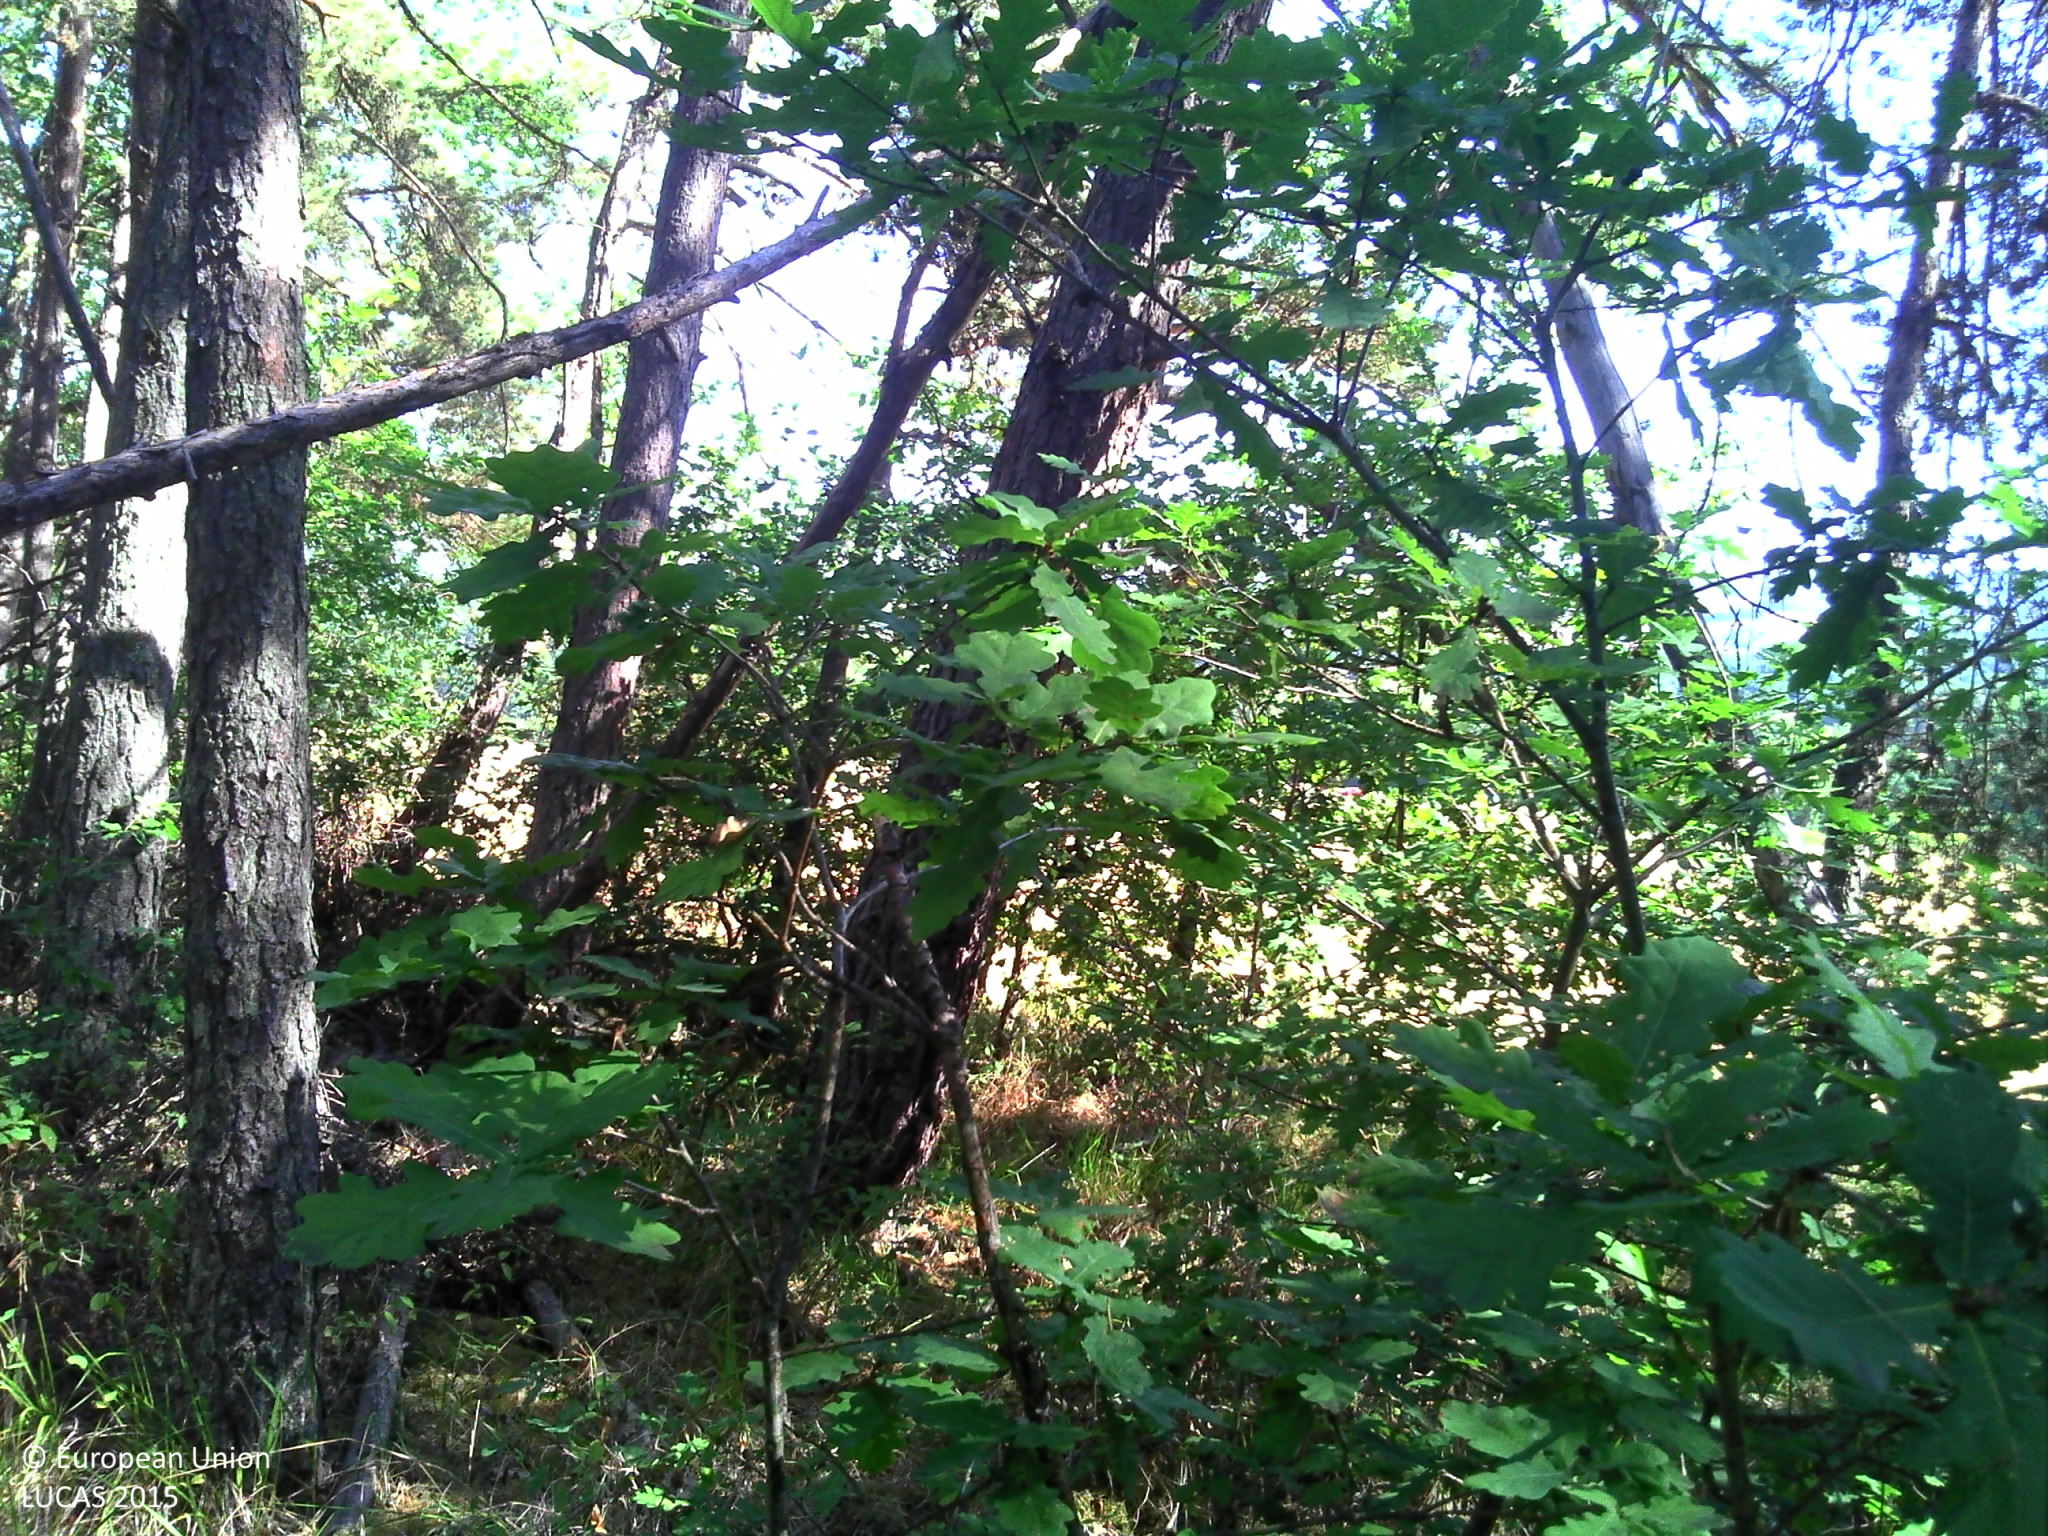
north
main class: Woodland
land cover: Pine dominated mixed woodland
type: acidophilous oak and oak-birch forest
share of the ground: > 75 %
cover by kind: coniferous forest trees 75 %, broadleaved forest trees 25 %
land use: Forestry
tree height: > 5 m
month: July
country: FR
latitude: 45.2836
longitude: 3.4622
